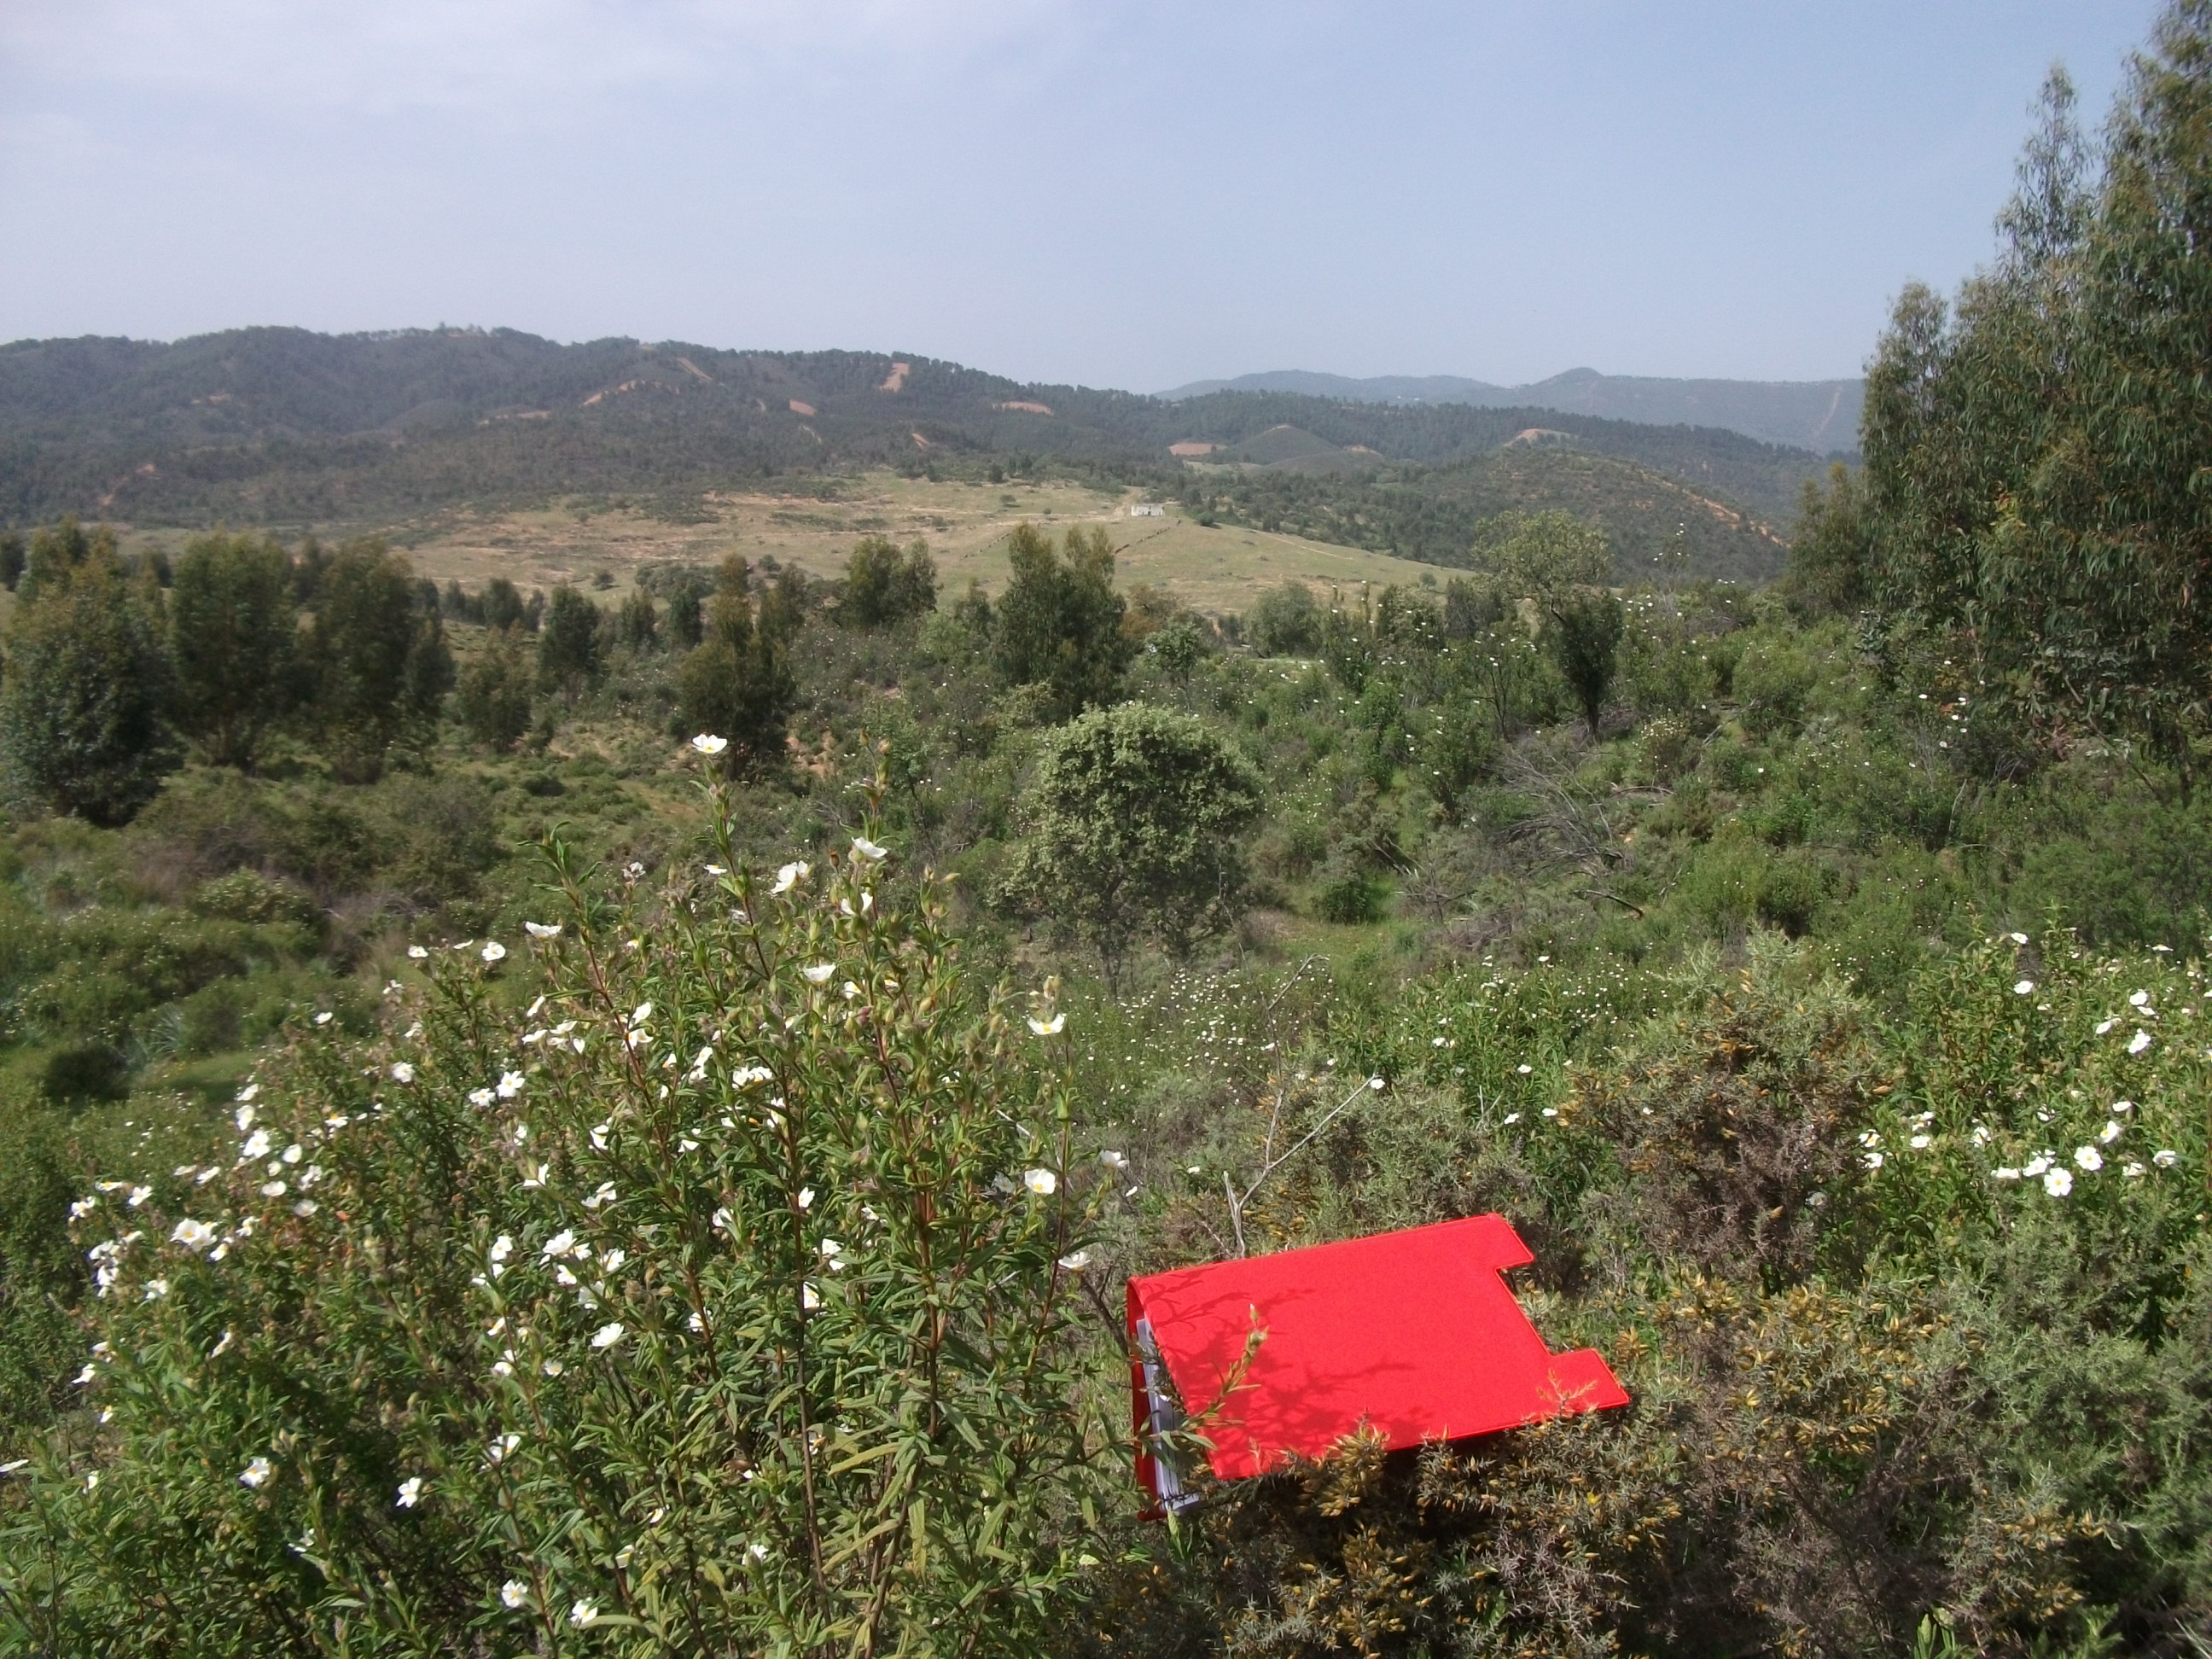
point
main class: Shrubland
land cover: Shrubland with sparse tree cover
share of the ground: > 75 %
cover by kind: shrubs 80 %, herbaceous plants 15 %, broadleaved forest trees 5 %
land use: Agriculture (excluding fallow land and kitchen gardens)
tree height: > 5 m
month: April
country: ES
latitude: 37.8049
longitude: -6.7296
